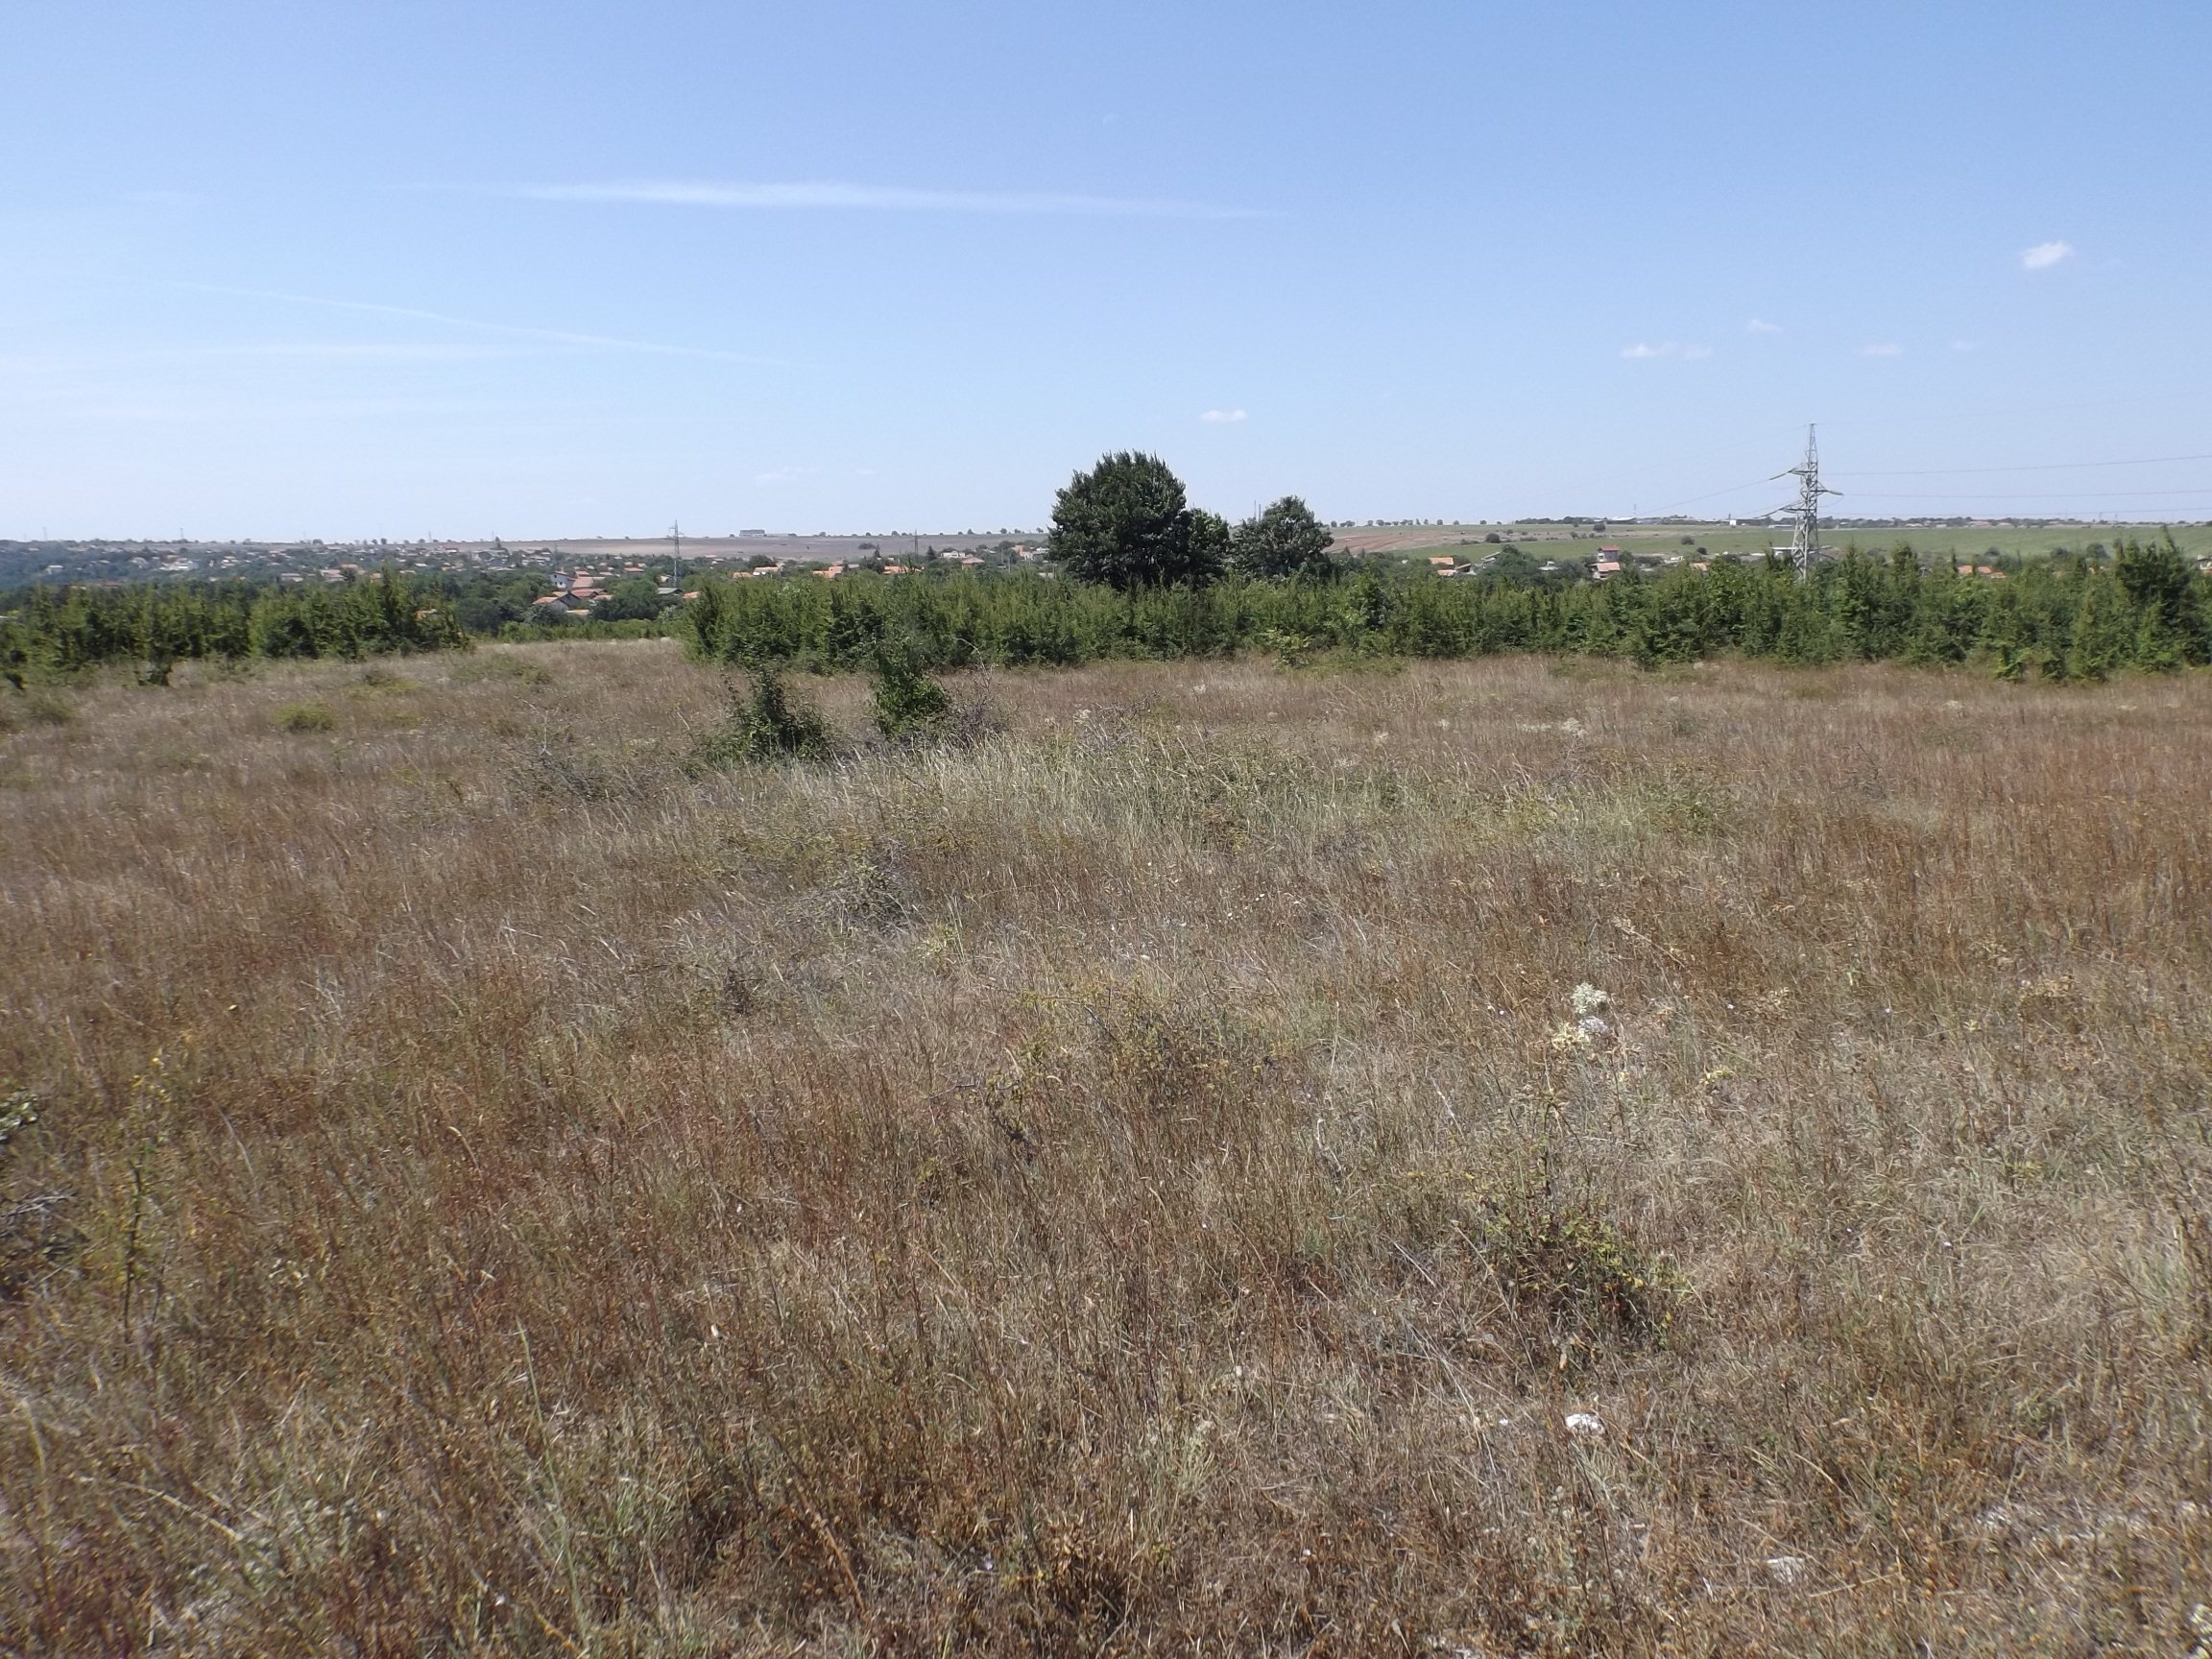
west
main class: Grassland
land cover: Grassland without tree/shrub cover
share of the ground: > 75 %
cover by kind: herbaceous plants 100 %
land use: Semi-natural and natural areas not in use
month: August
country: BG
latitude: 43.2600
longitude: 27.9921
